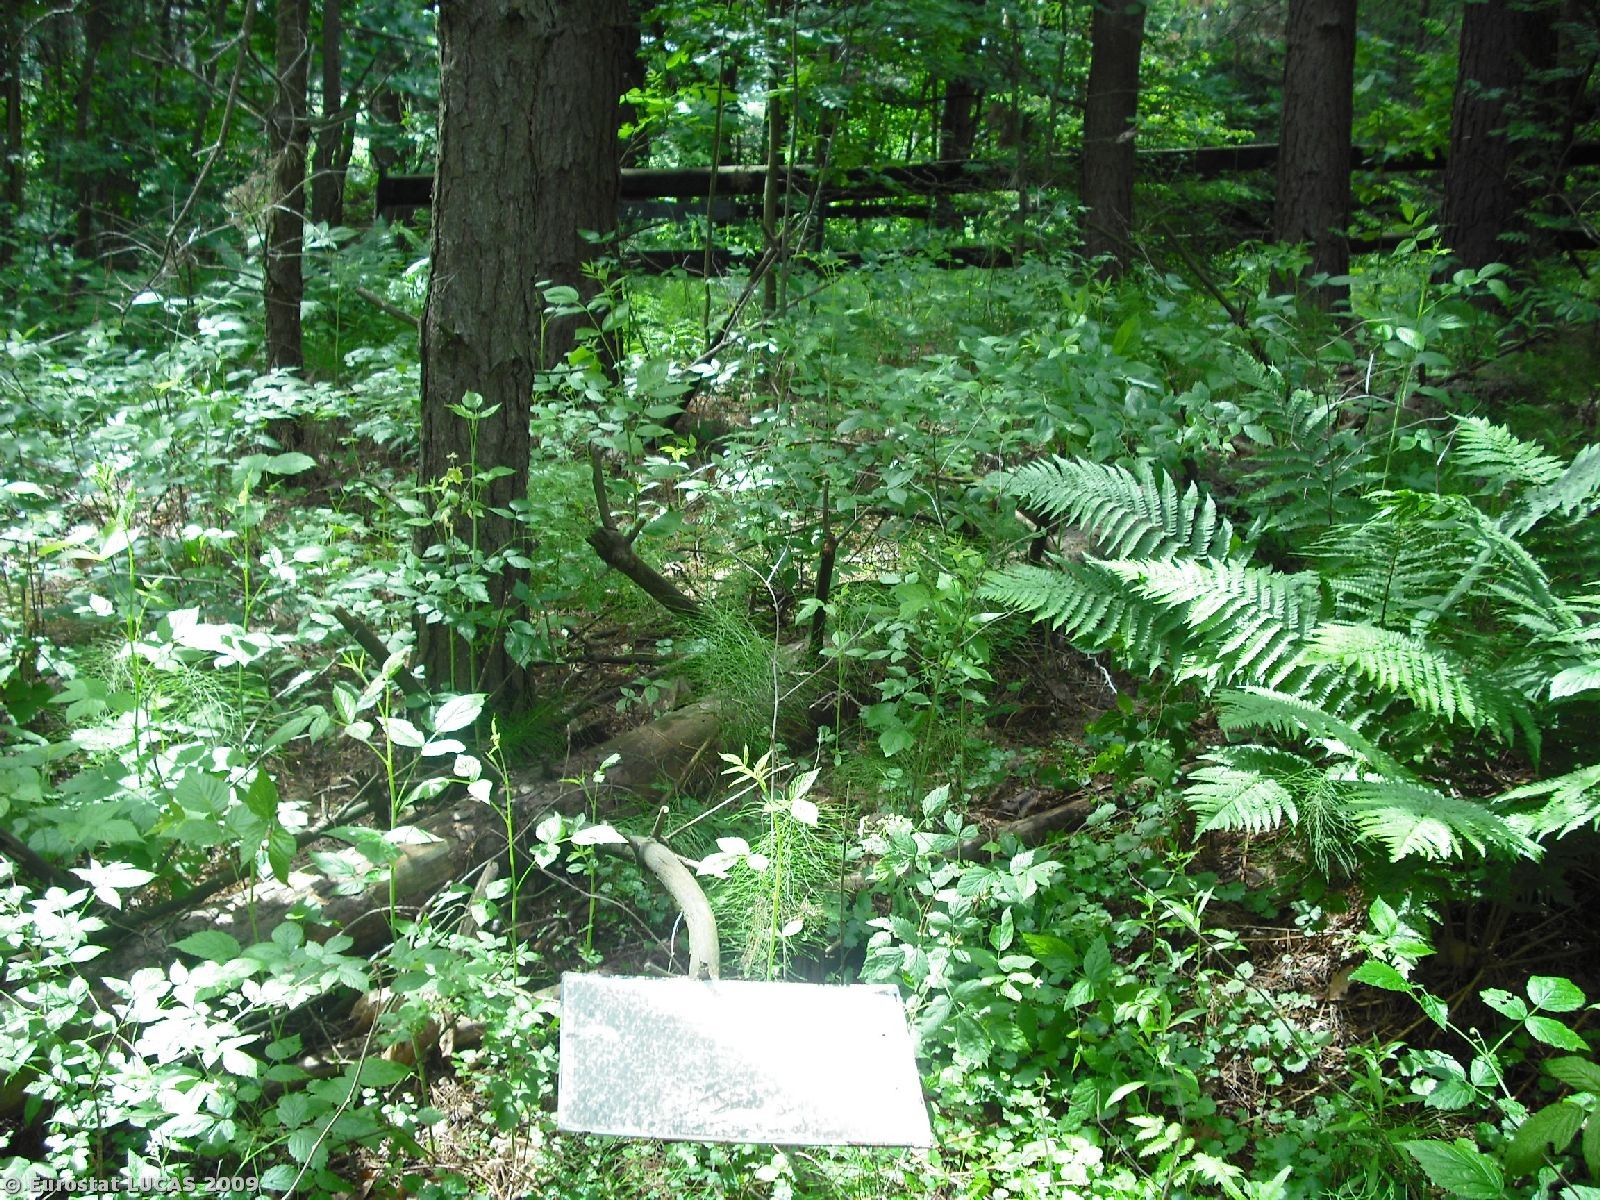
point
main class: Woodland
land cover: Coniferous woodland
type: hemiboreal forest and nemoral coniferous forest and mixed broadleaved-coniferous forest
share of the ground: > 75 %
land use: Forestry
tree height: > 5 m
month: June
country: PL
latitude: 54.2614
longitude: 22.8587
